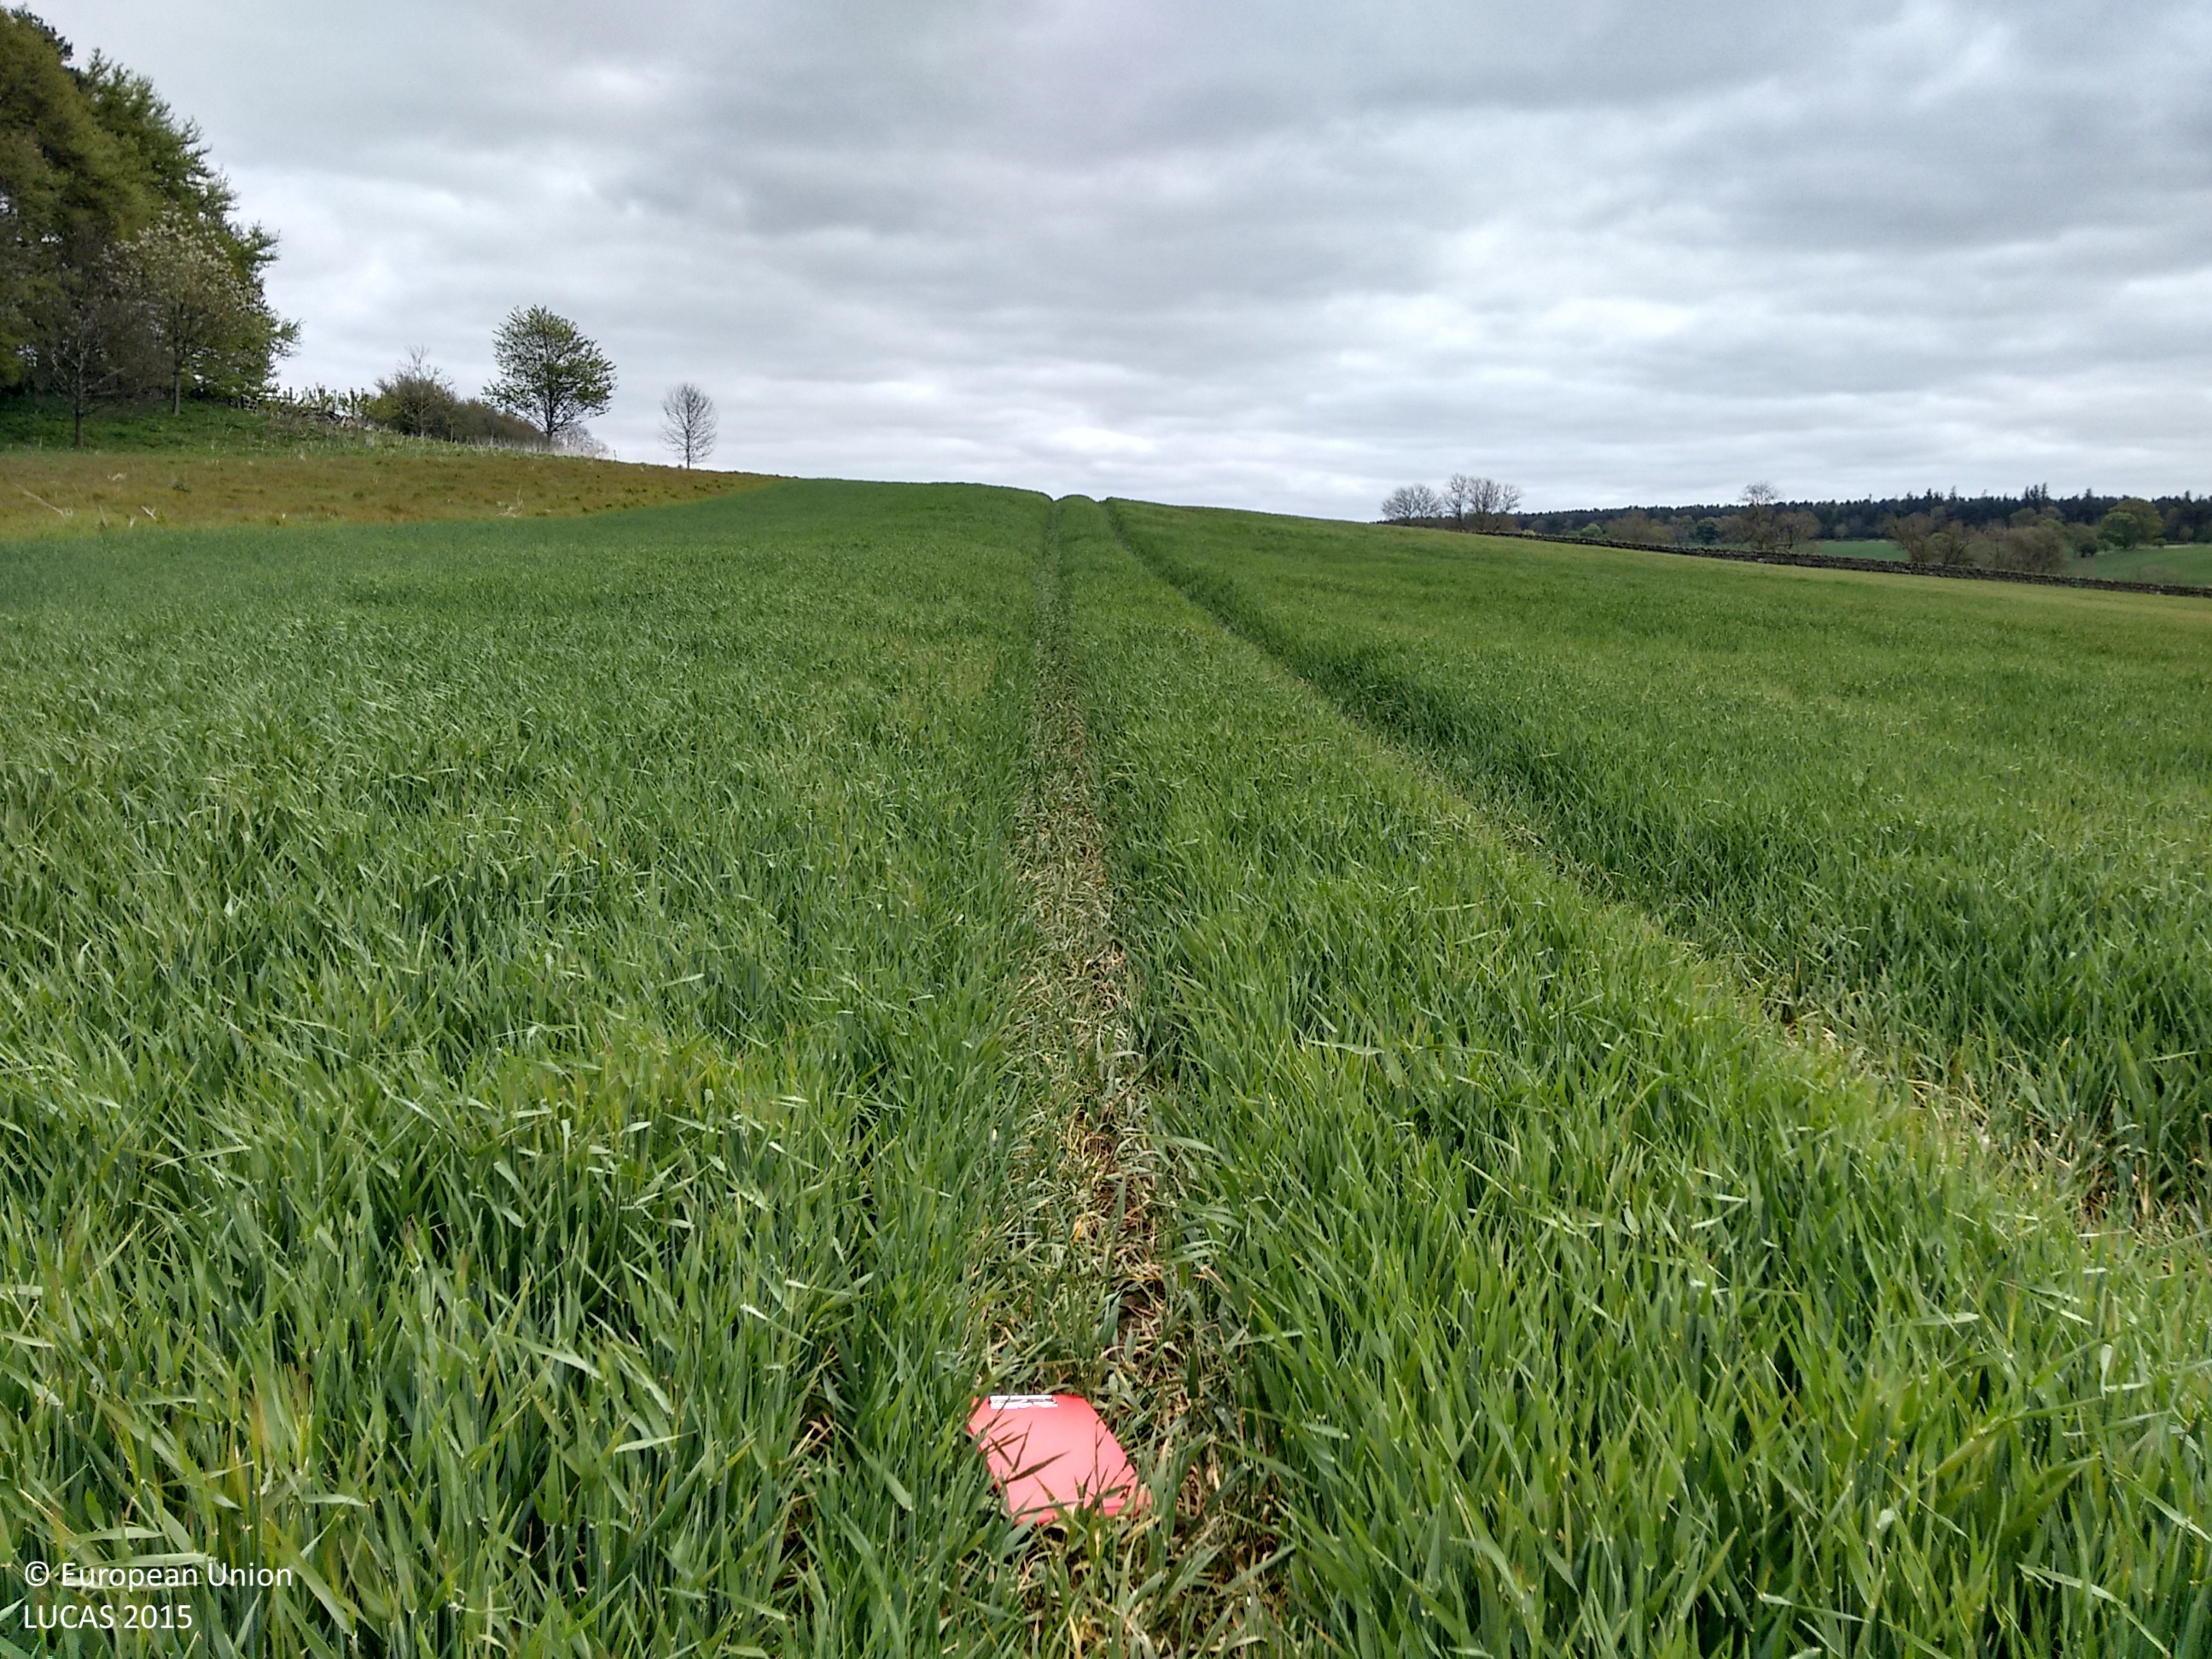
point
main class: Cropland
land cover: Barley
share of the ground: > 75 %
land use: Agriculture (excluding fallow land and kitchen gardens)
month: May
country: GB
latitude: 55.0668
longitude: -2.0977
